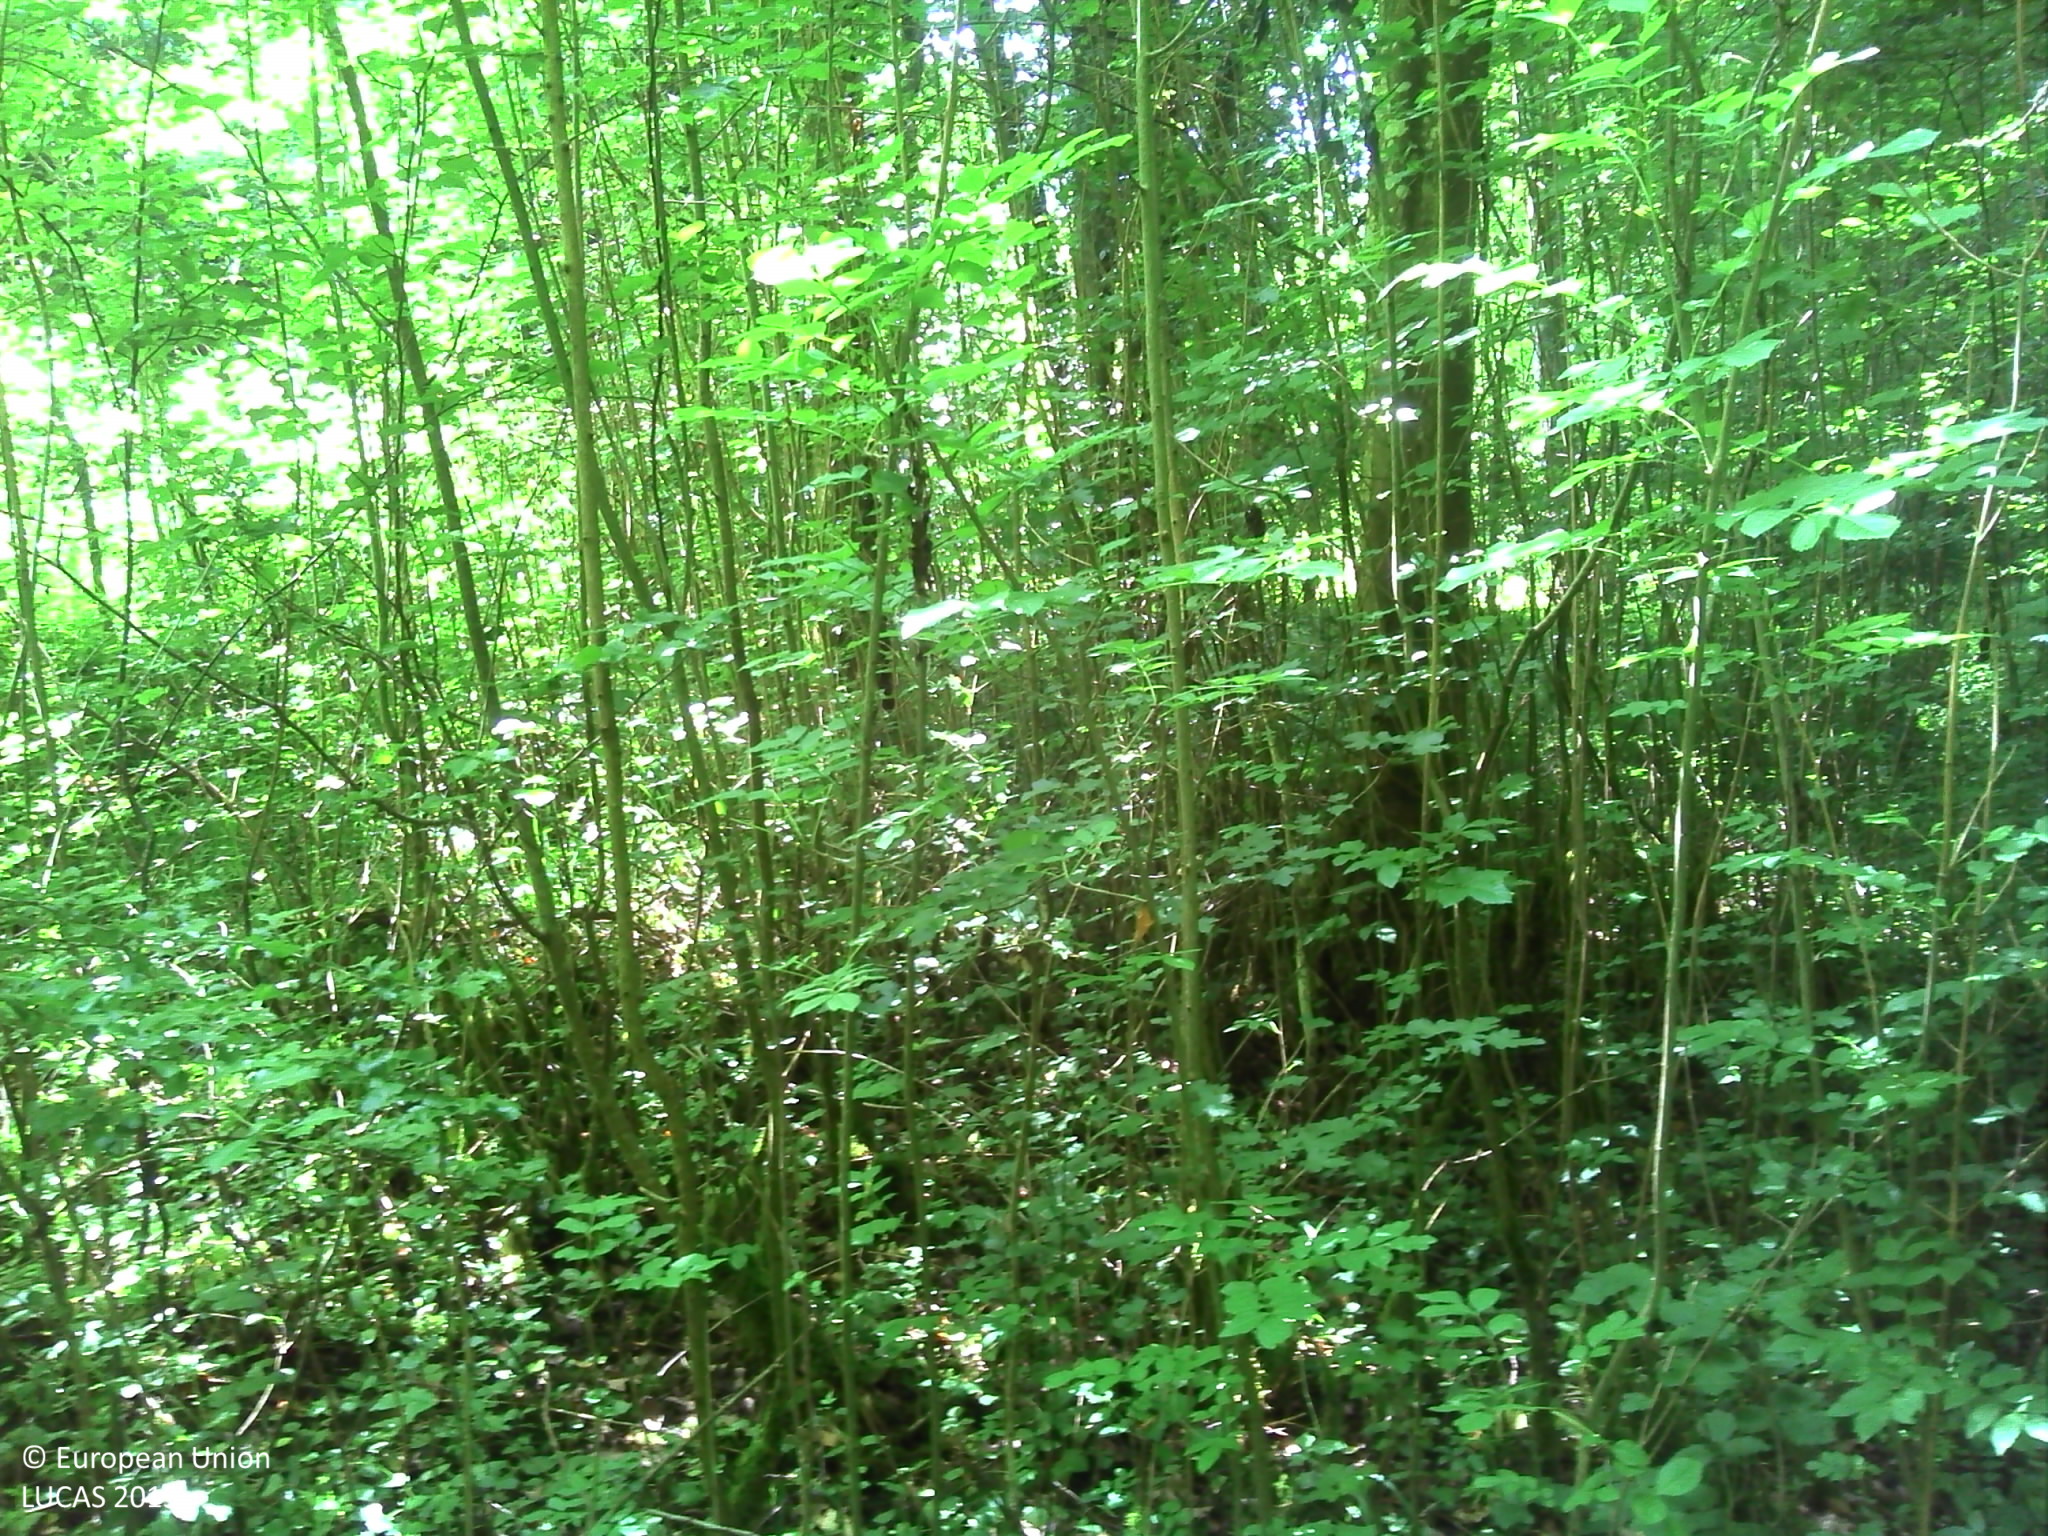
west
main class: Woodland
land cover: Broadleaved woodland
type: mesophytic deciduous forest
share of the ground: > 75 %
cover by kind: broadleaved forest trees 85 %, herbaceous plants 10 %, lichens and mosses 5 %
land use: Forestry
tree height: > 5 m
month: June
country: FR
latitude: 49.2336
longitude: 1.0379
